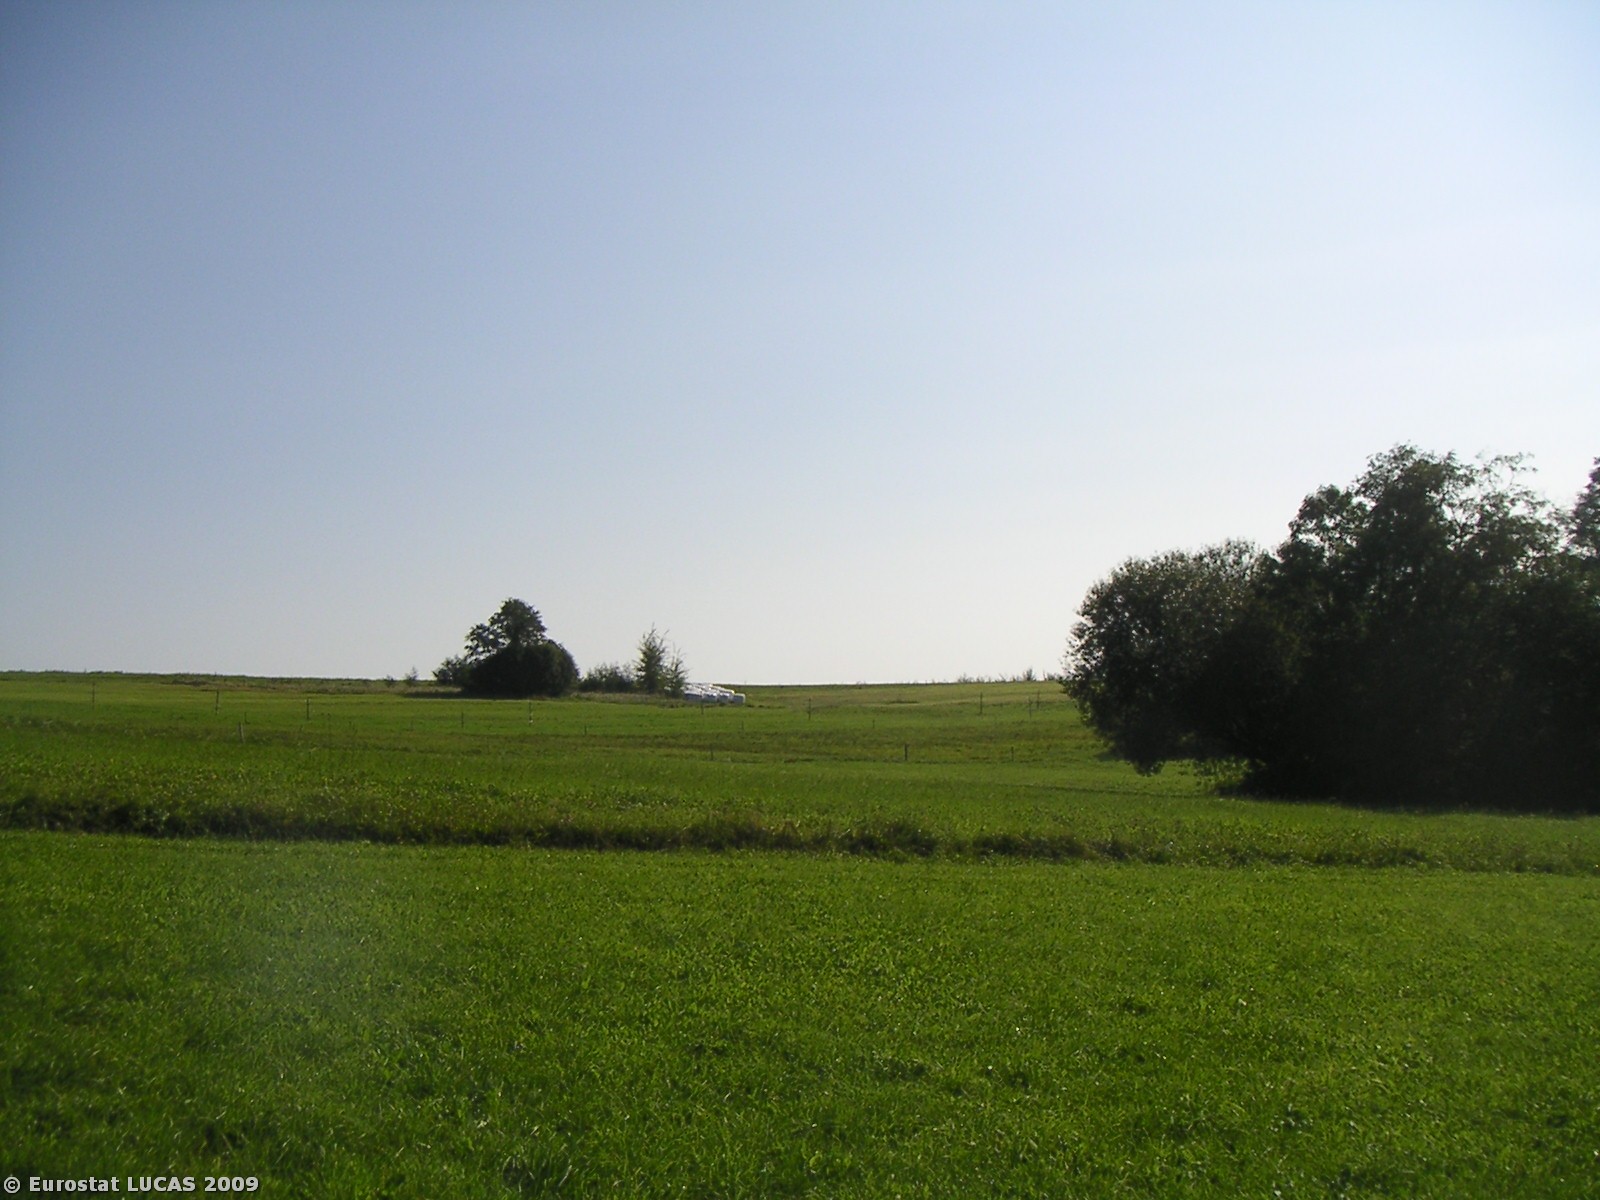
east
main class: Grassland
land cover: Grassland without tree/shrub cover
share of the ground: > 75 %
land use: Agriculture (excluding fallow land and kitchen gardens)
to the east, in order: Grassland without tree/shrub cover; Fences; Grassland without tree/shrub cover; Fences; Grassland without tree/shrub cover; Clovers; Fences; Grassland without tree/shrub cover
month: September
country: PL
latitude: 49.4102
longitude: 20.0798
